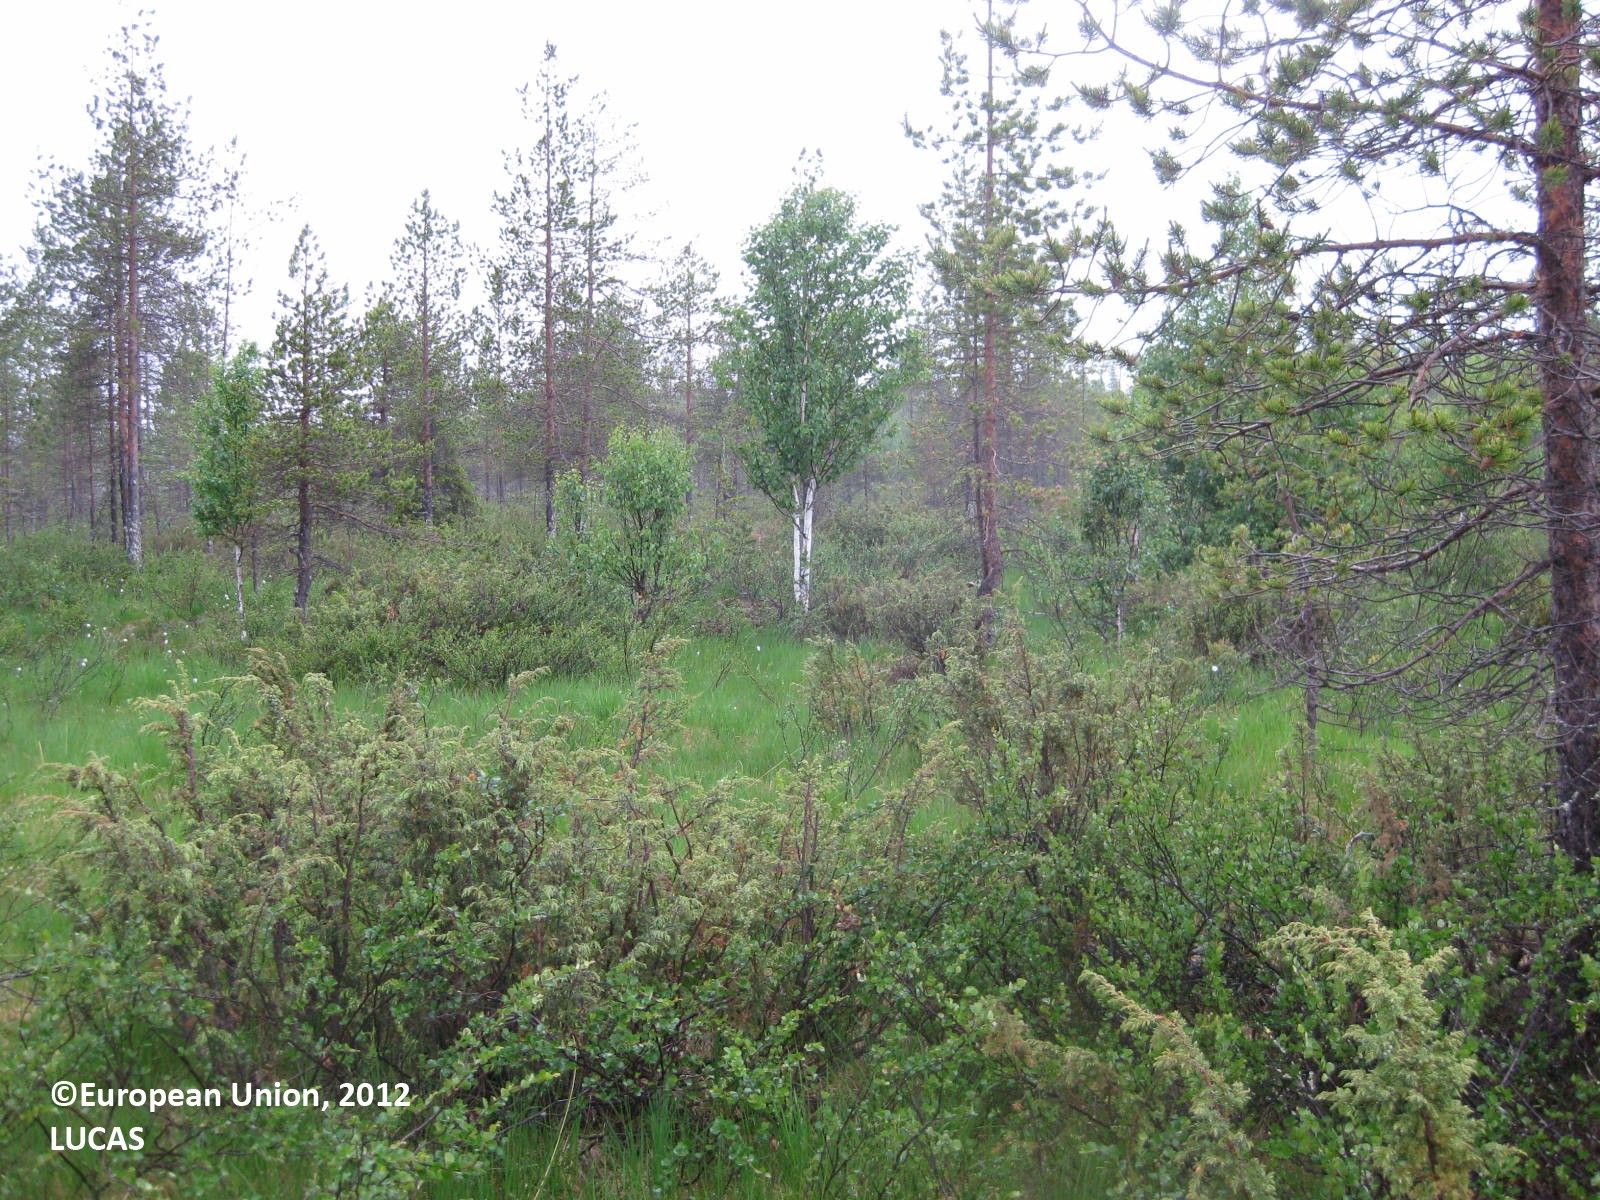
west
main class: Woodland
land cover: Pine dominated coniferous woodland
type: boreal forest
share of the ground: 25 - 50 %
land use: Forestry
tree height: > 5 m
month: July
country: FI
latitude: 65.6479
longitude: 29.4733
